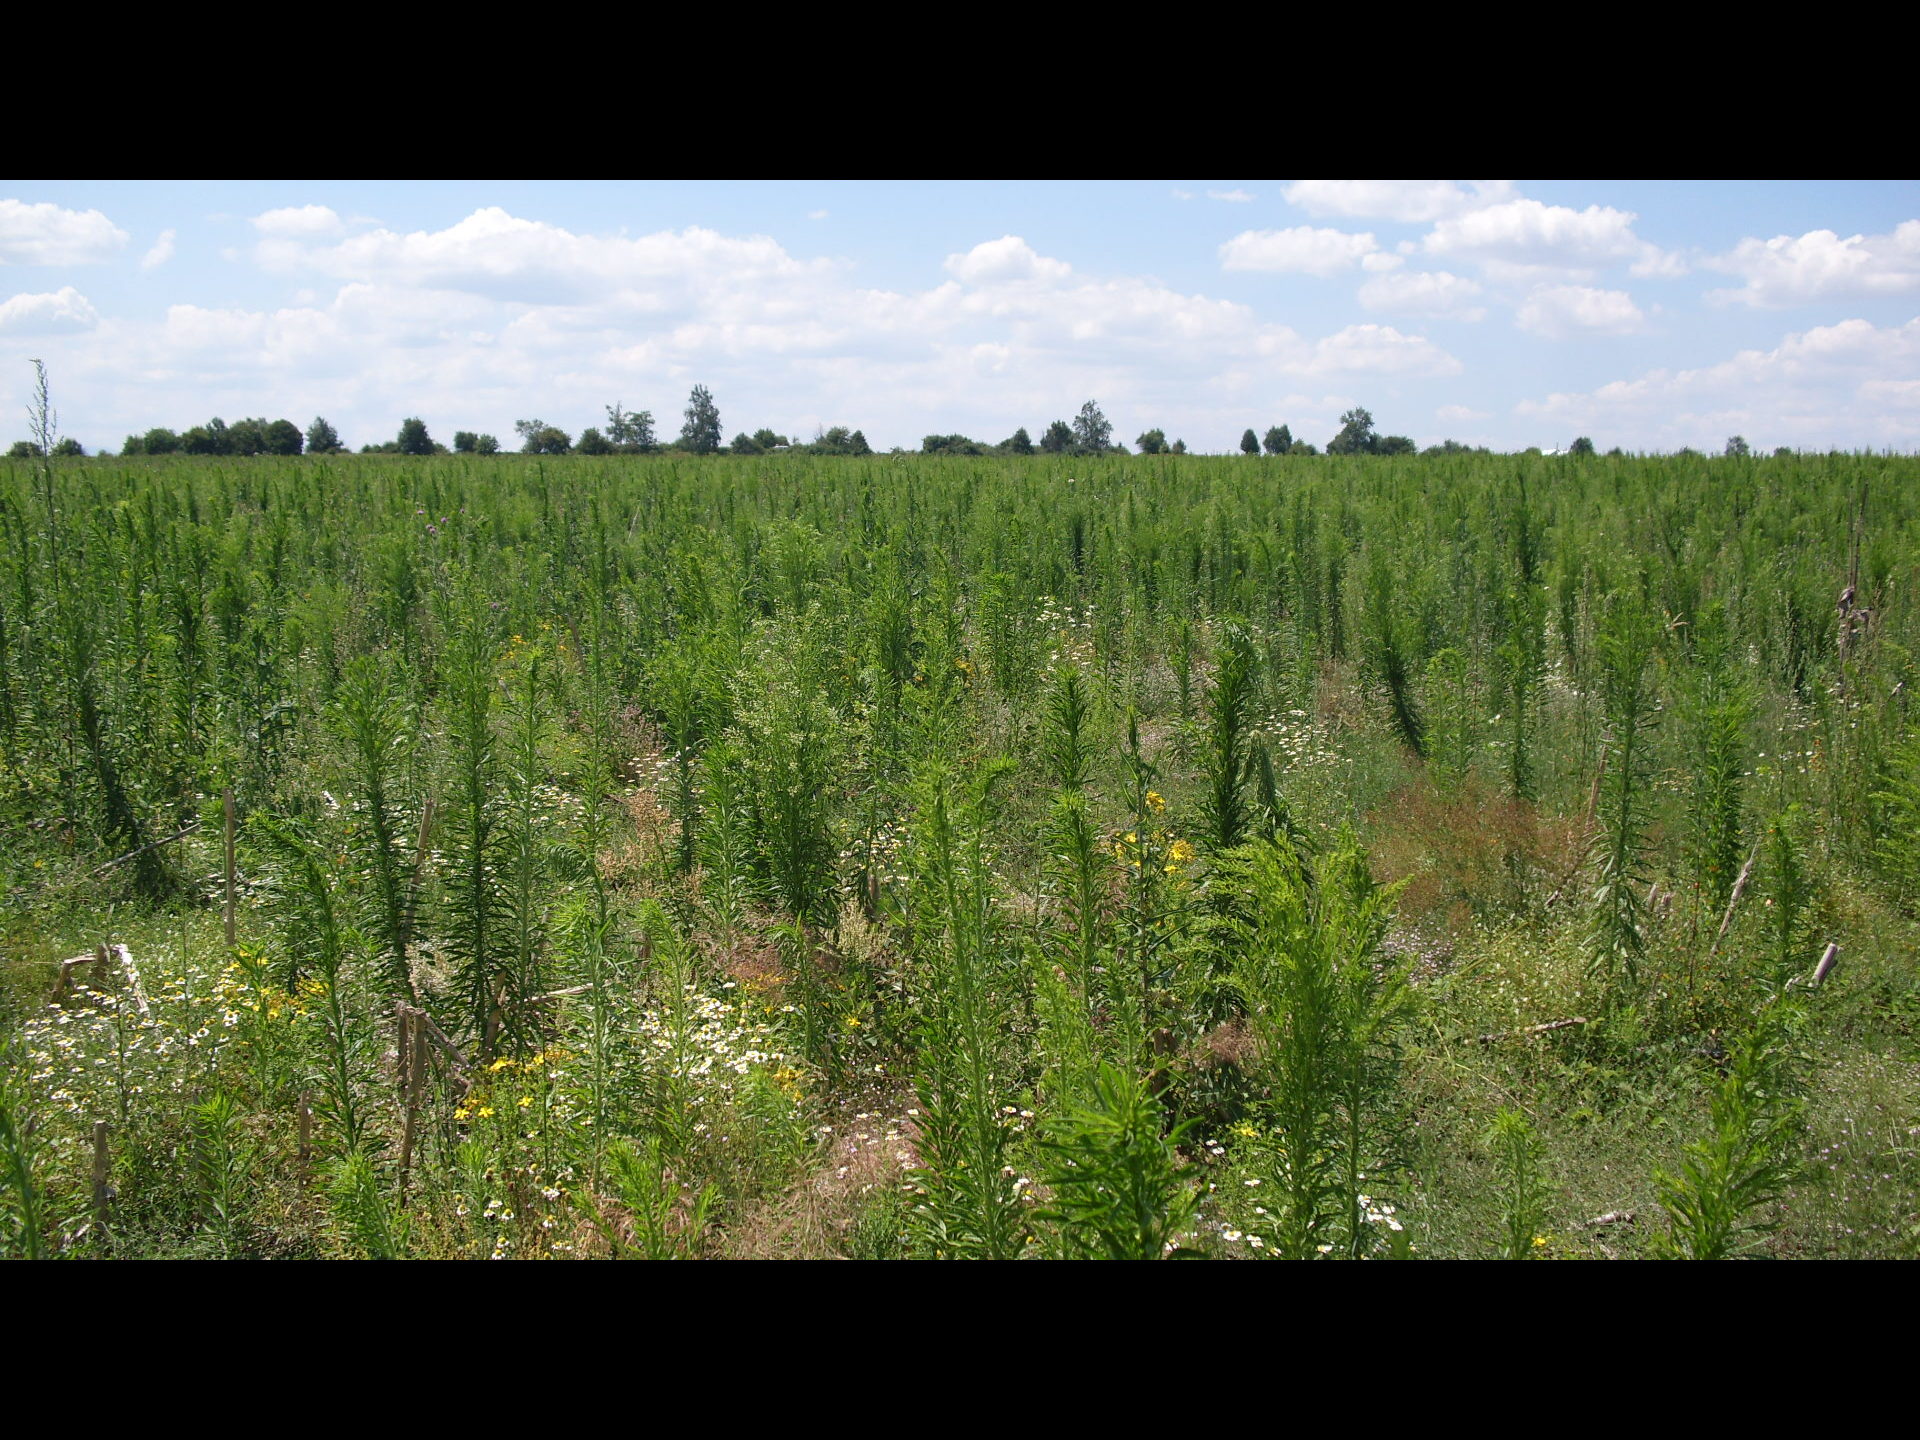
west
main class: Grassland
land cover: Spontaneously vegetated surfaces
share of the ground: > 75 %
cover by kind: herbaceous plants 95 %, shrubs 5 %
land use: Fallow land
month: July
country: BG
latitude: 43.5945
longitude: 23.0574
